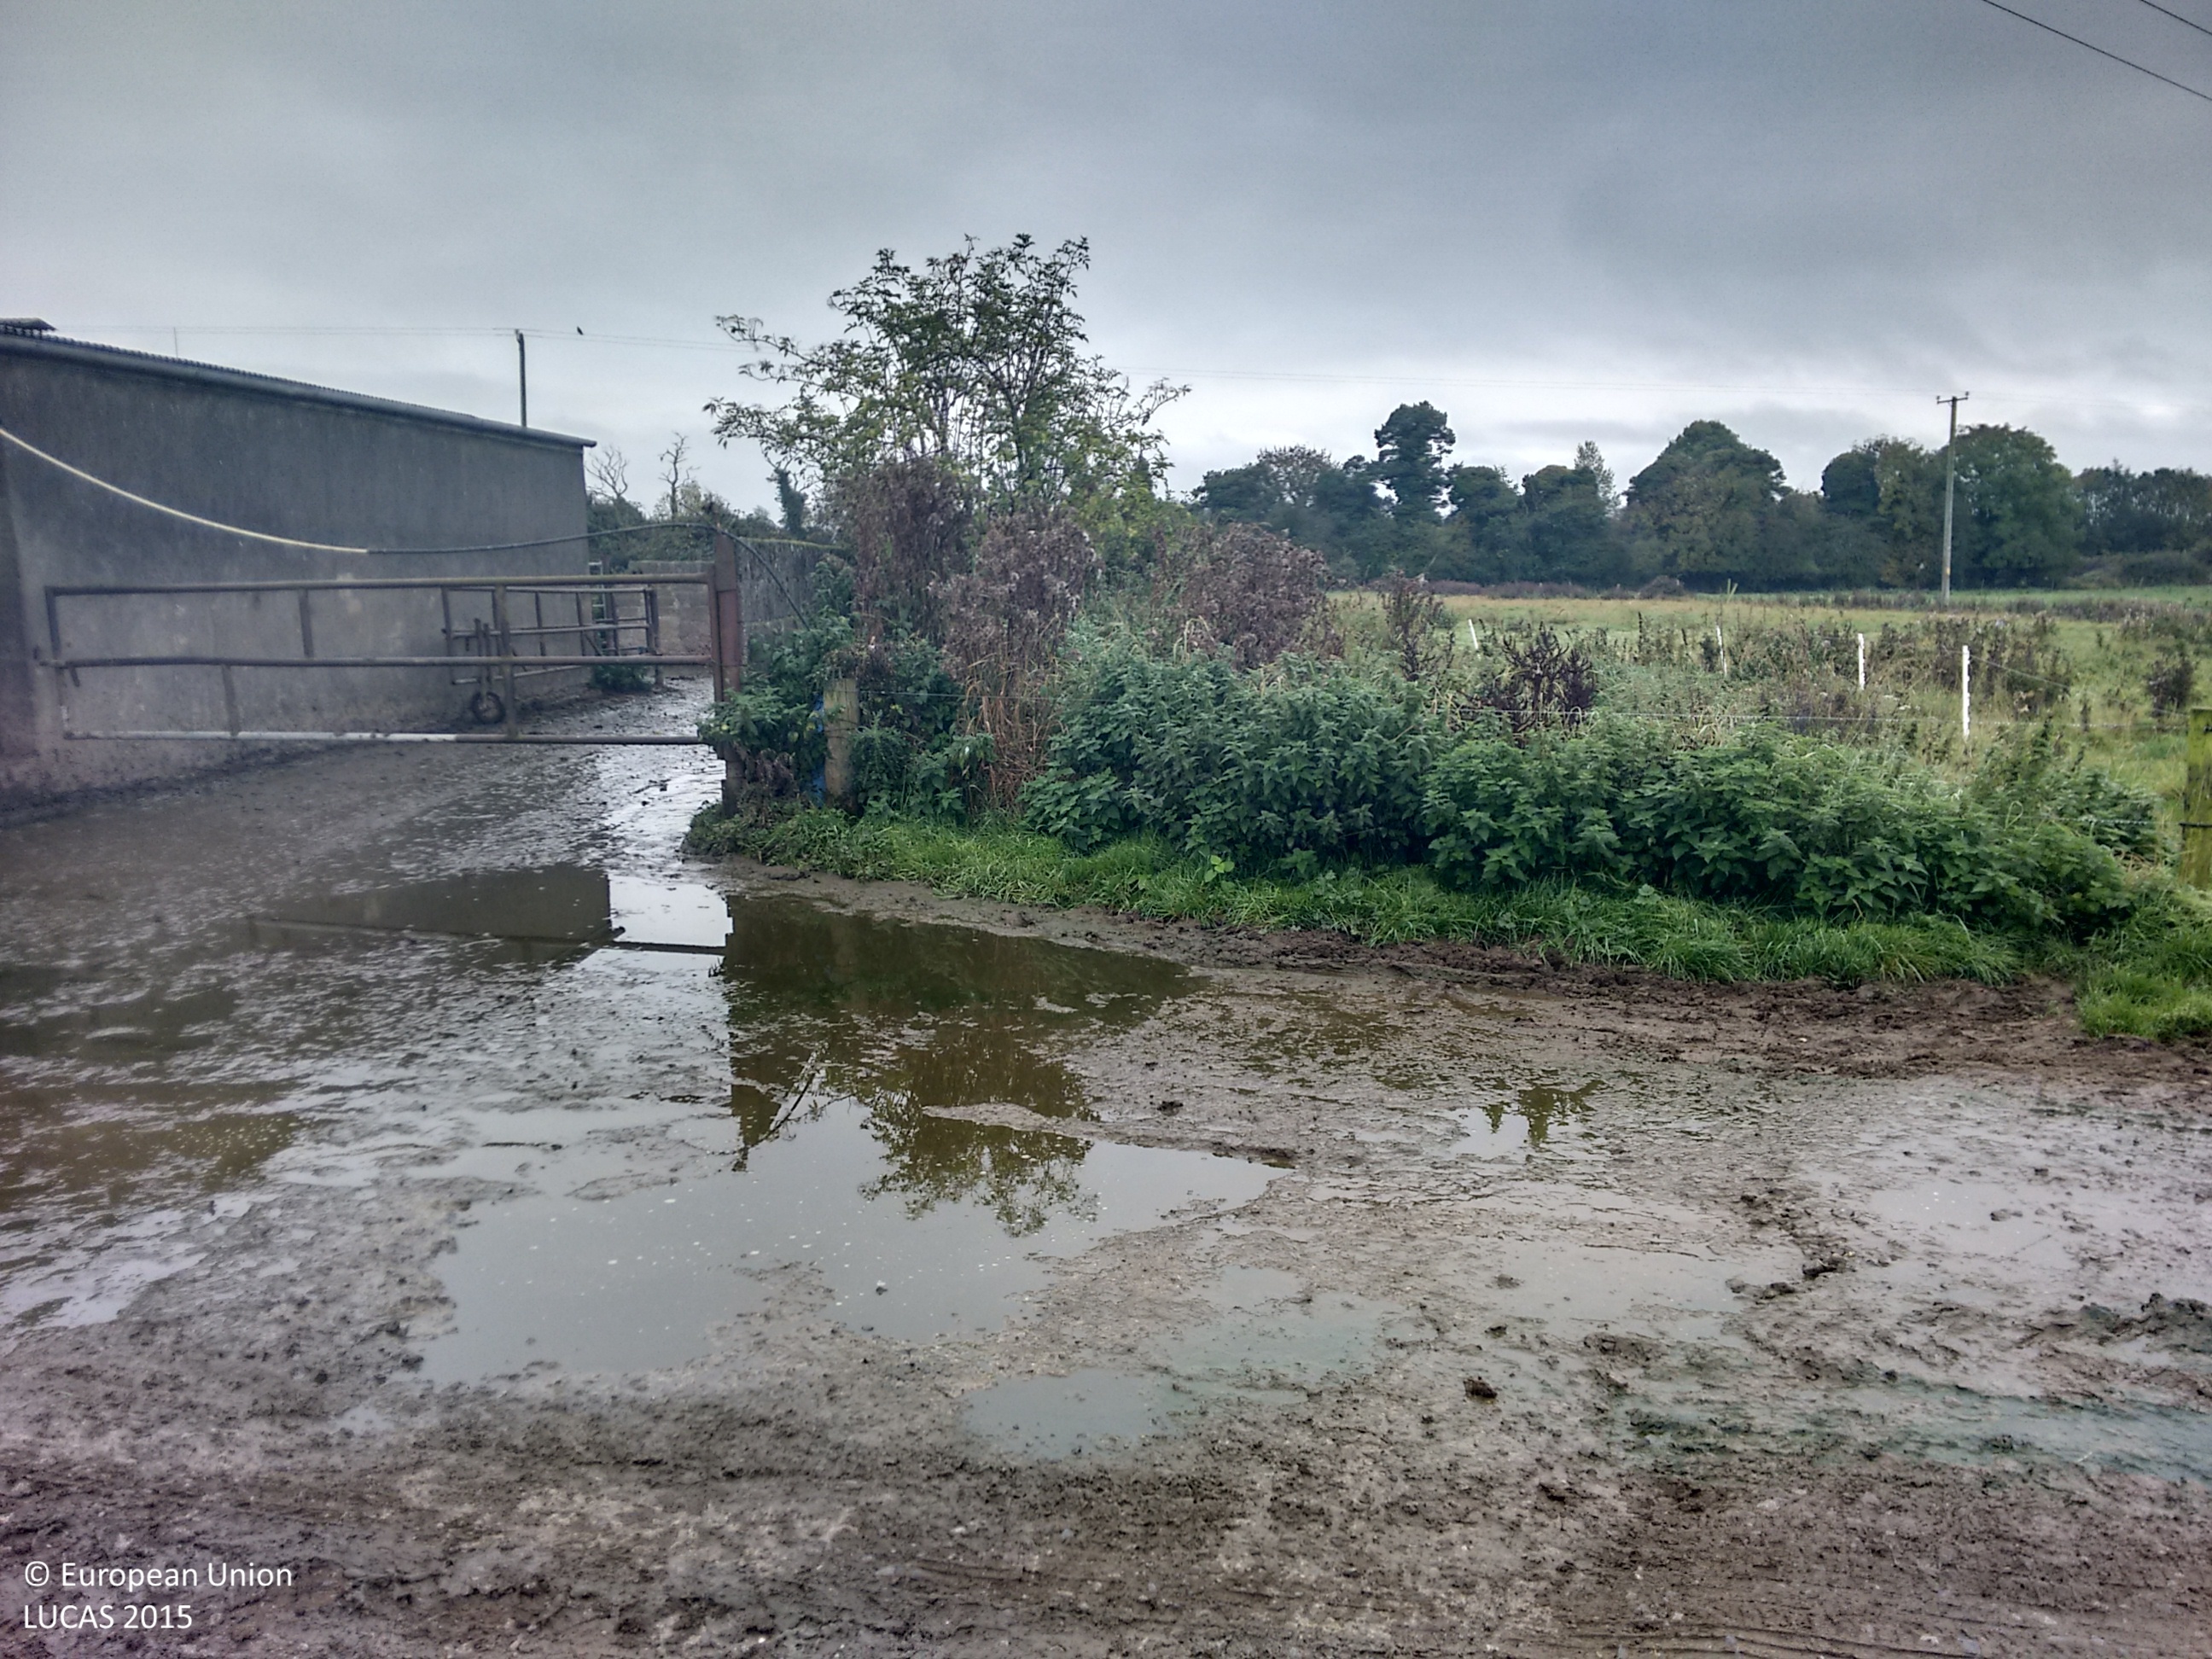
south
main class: Grassland
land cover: Grassland without tree/shrub cover
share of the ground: > 75 %
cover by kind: herbaceous plants 100 %
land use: Agriculture (excluding fallow land and kitchen gardens)
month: October
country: IE
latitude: 52.6477
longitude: -7.7409
